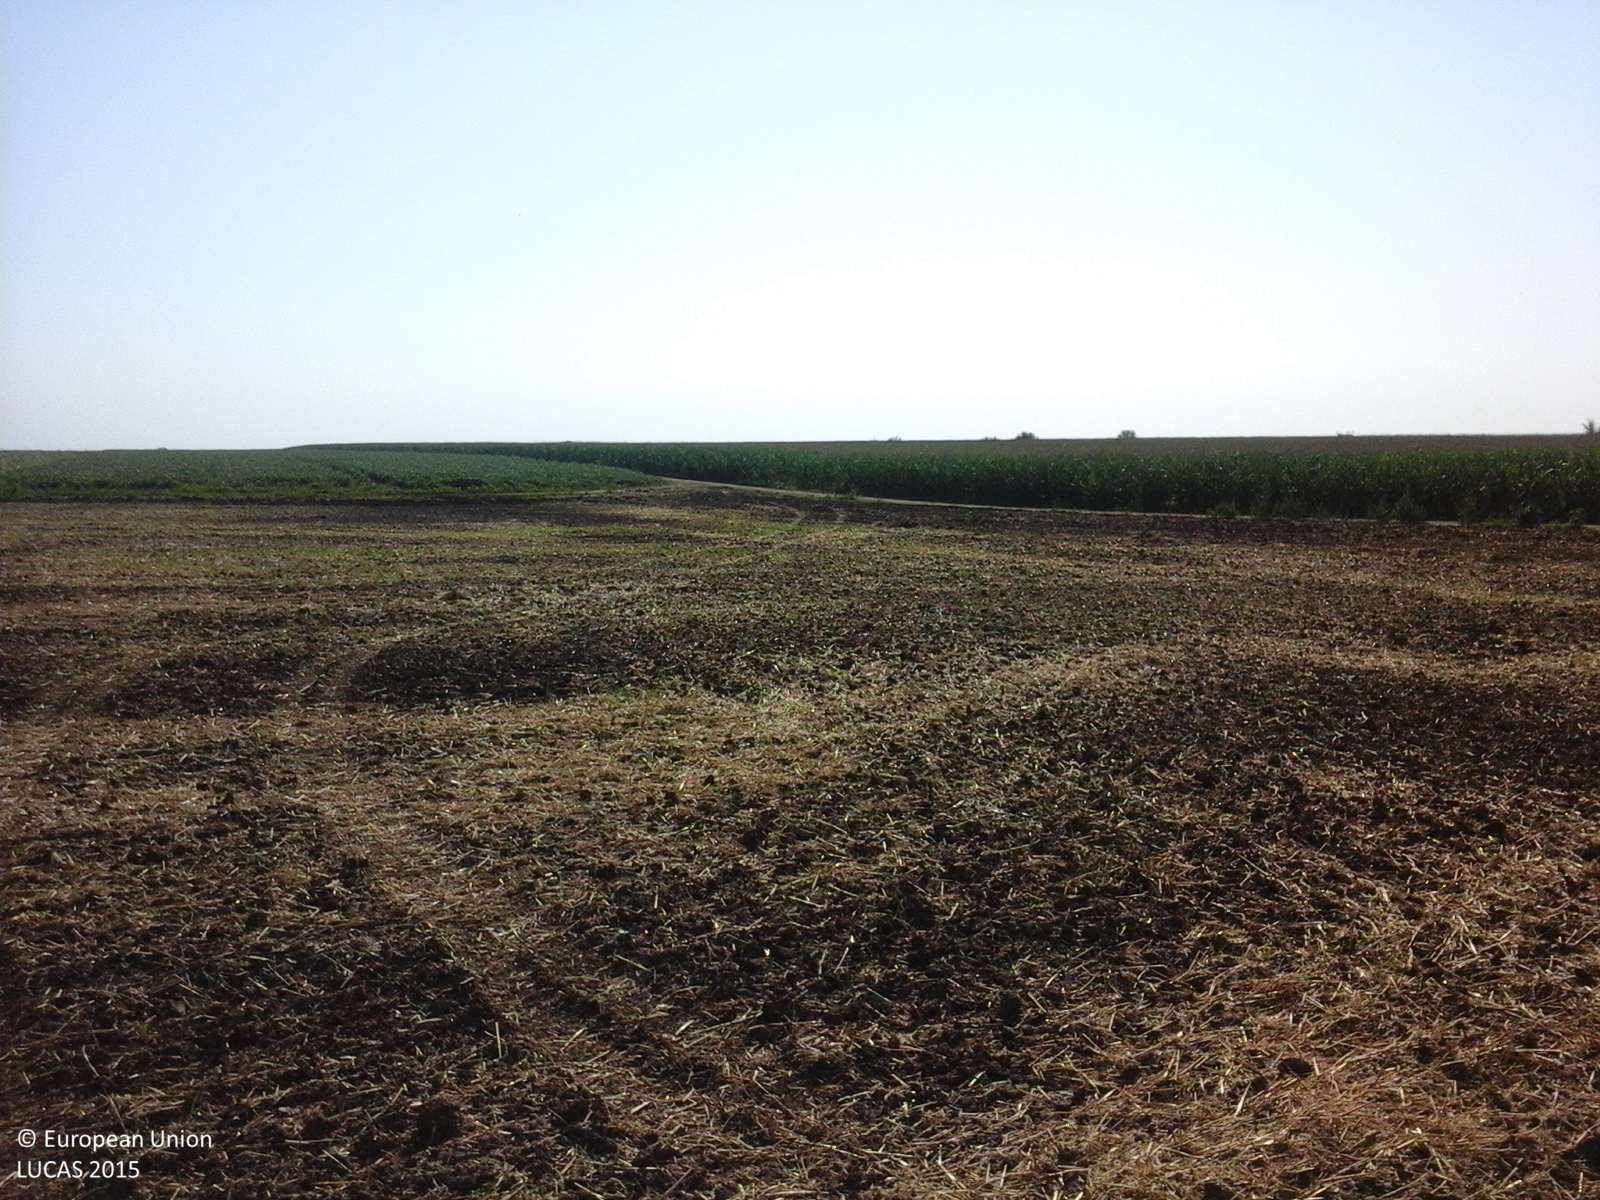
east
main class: Cropland
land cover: Durum wheat
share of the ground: < 10 %
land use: Agriculture (excluding fallow land and kitchen gardens)
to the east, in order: Durum wheat; Grass margins; Tracks; Maize
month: July
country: RO
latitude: 44.3567
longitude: 27.5184
